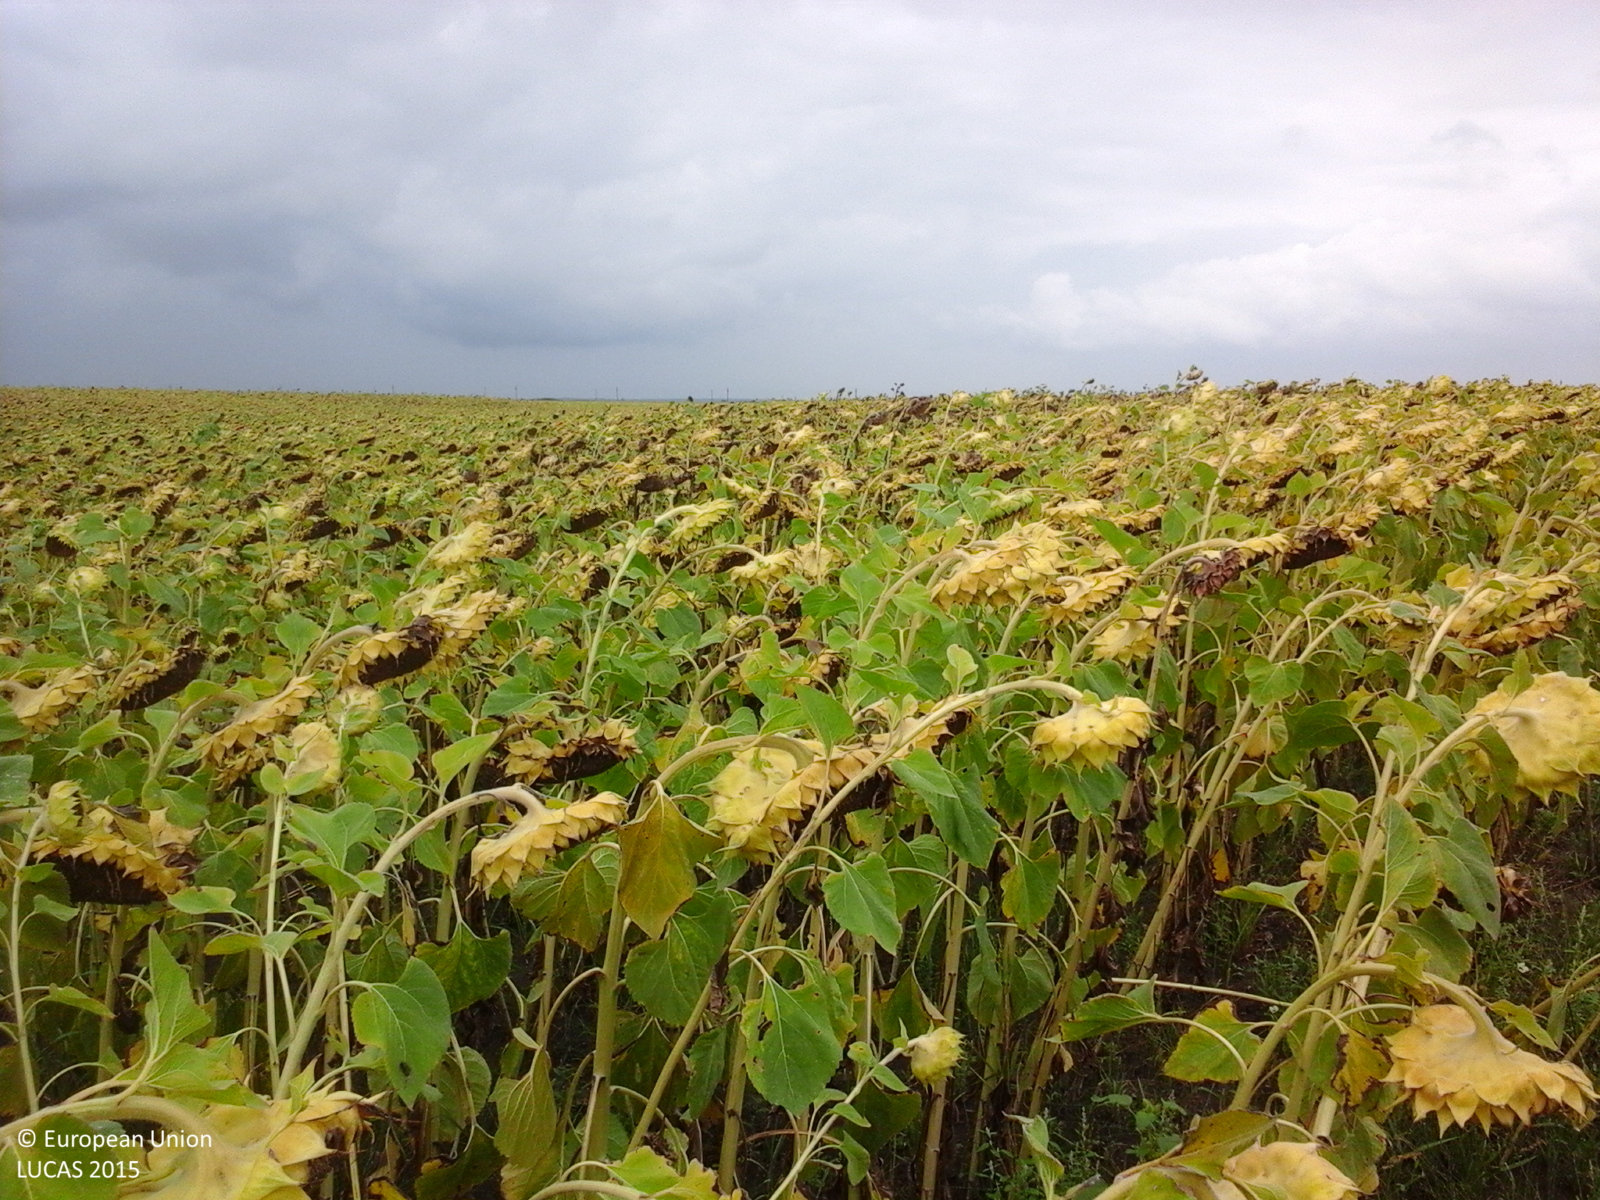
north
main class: Cropland
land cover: Sunflower
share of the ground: > 75 %
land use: Agriculture (excluding fallow land and kitchen gardens)
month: August
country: RO
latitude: 46.0859
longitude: 20.5129
